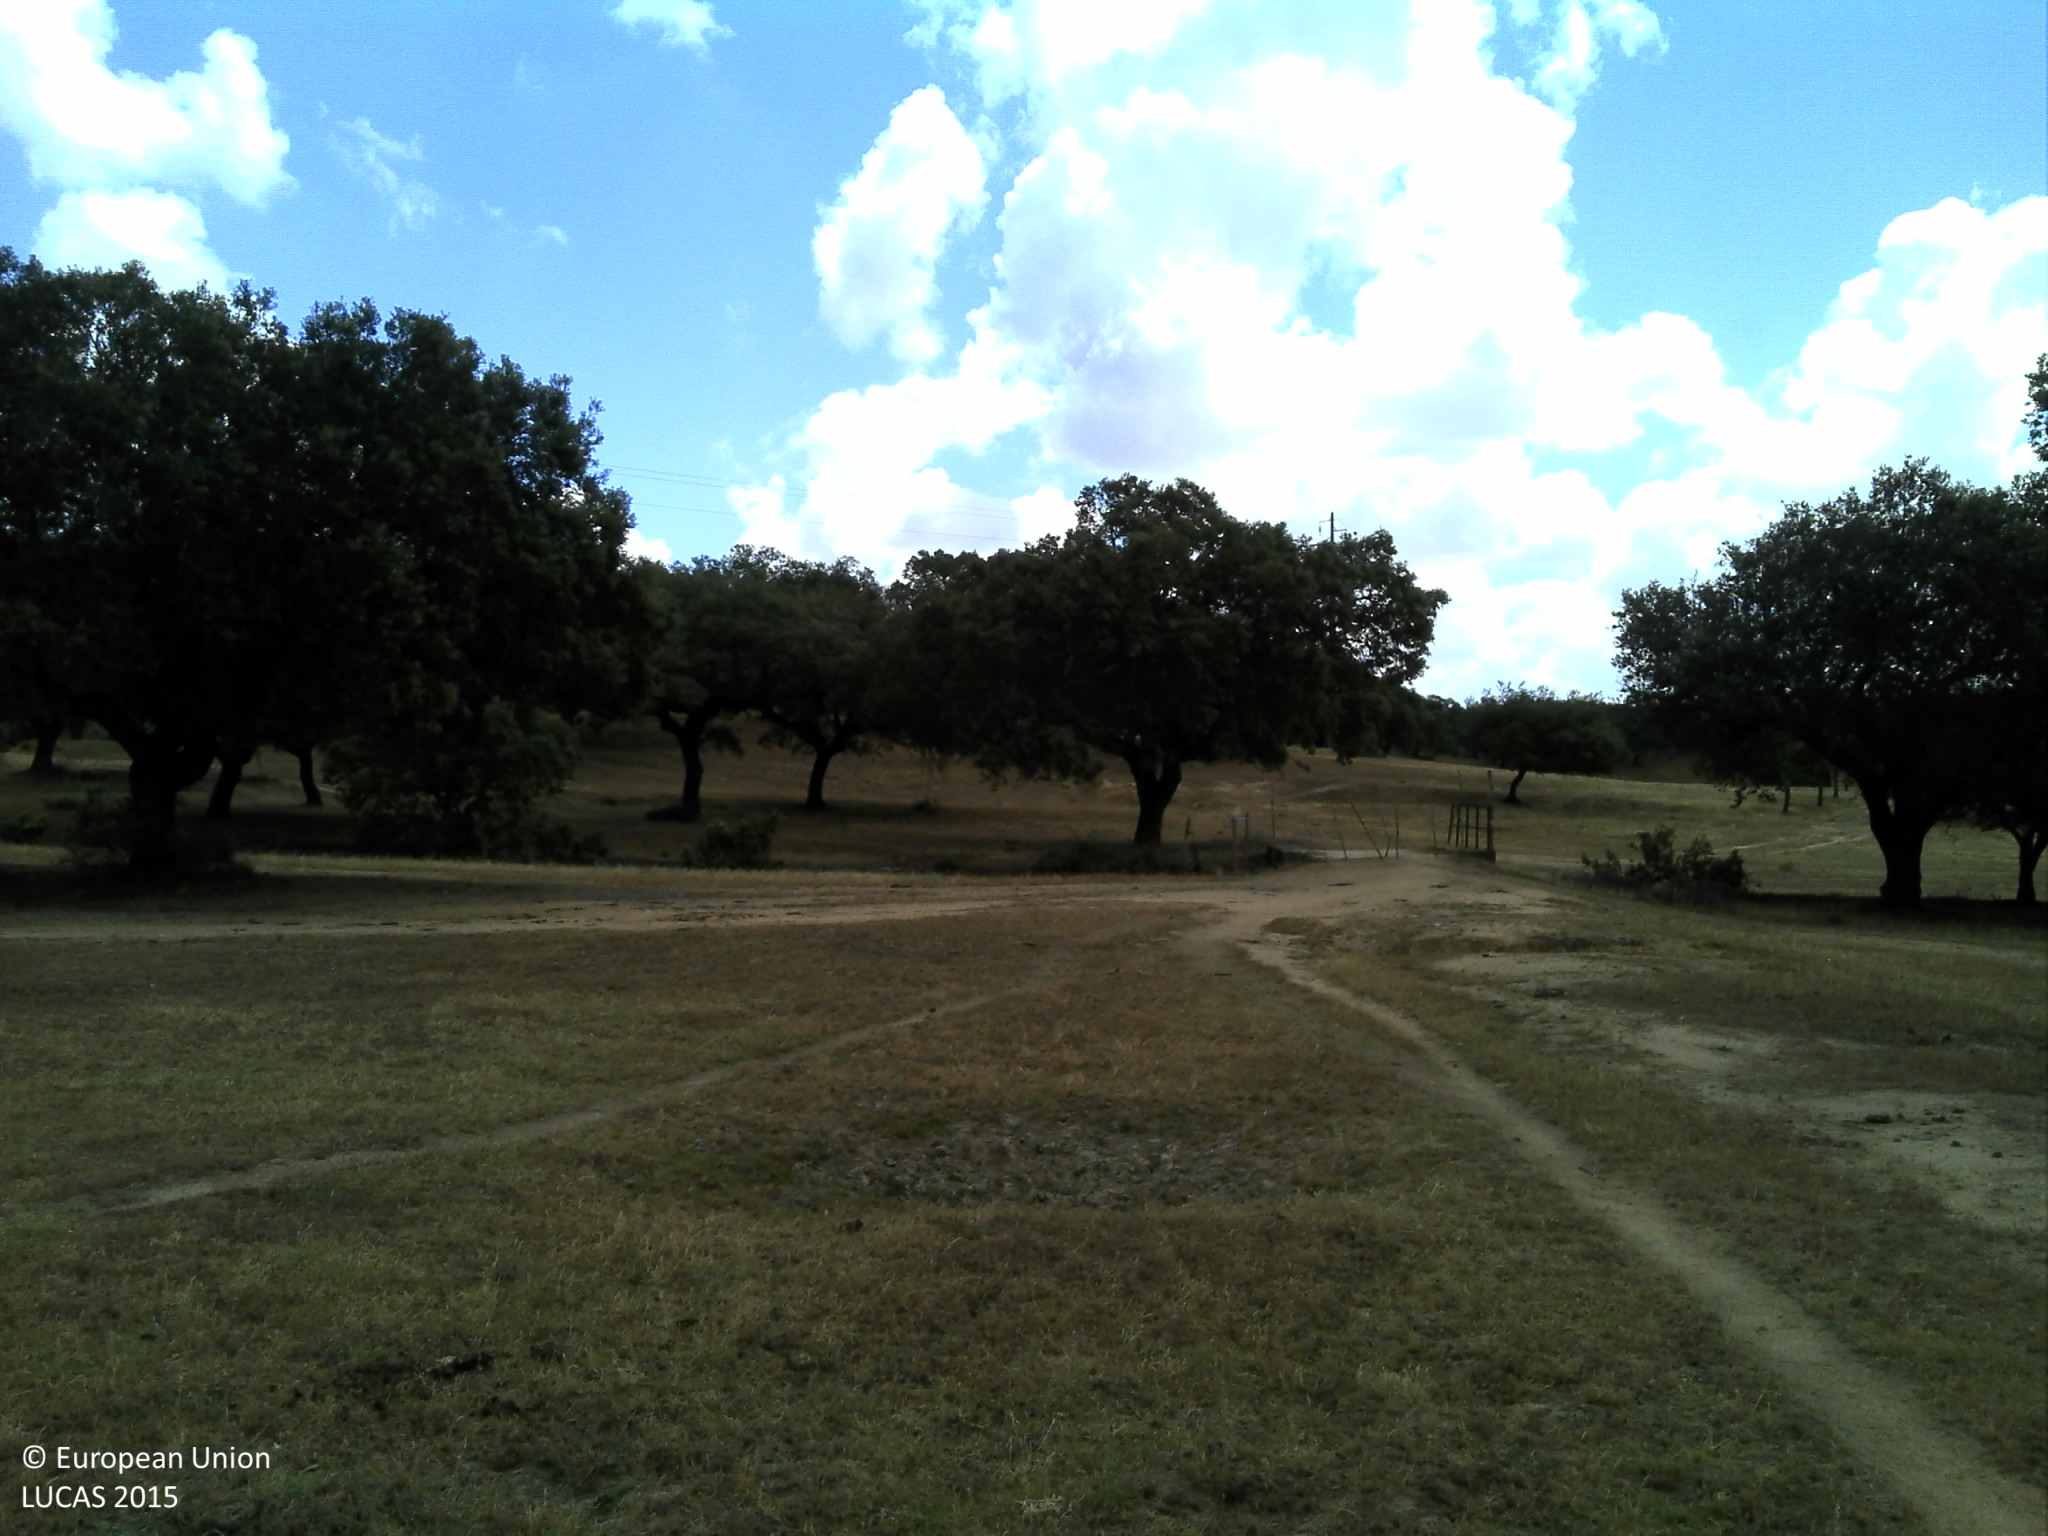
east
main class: Woodland
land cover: Broadleaved woodland
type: broadleaved evergreen forest
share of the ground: 10 - 25 %
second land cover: Grassland without tree/shrub cover
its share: 10 - 25 %
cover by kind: unconsolidated bare surface 70 %, broadleaved forest trees 15 %, herbaceous plants 15 %
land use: Forestry
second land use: Agriculture (excluding fallow land and kitchen gardens)
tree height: > 5 m
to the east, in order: Broadleaved woodland; Grassland without tree/shrub cover; Broadleaved woodland; Ditches and canals; Spontaneously vegetated surfaces; Tracks; Spontaneously vegetated surfaces; Electric lines; Spontaneously vegetated surfaces; Broadleaved woodland
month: June
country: PT
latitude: 38.5199
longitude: -8.0609
